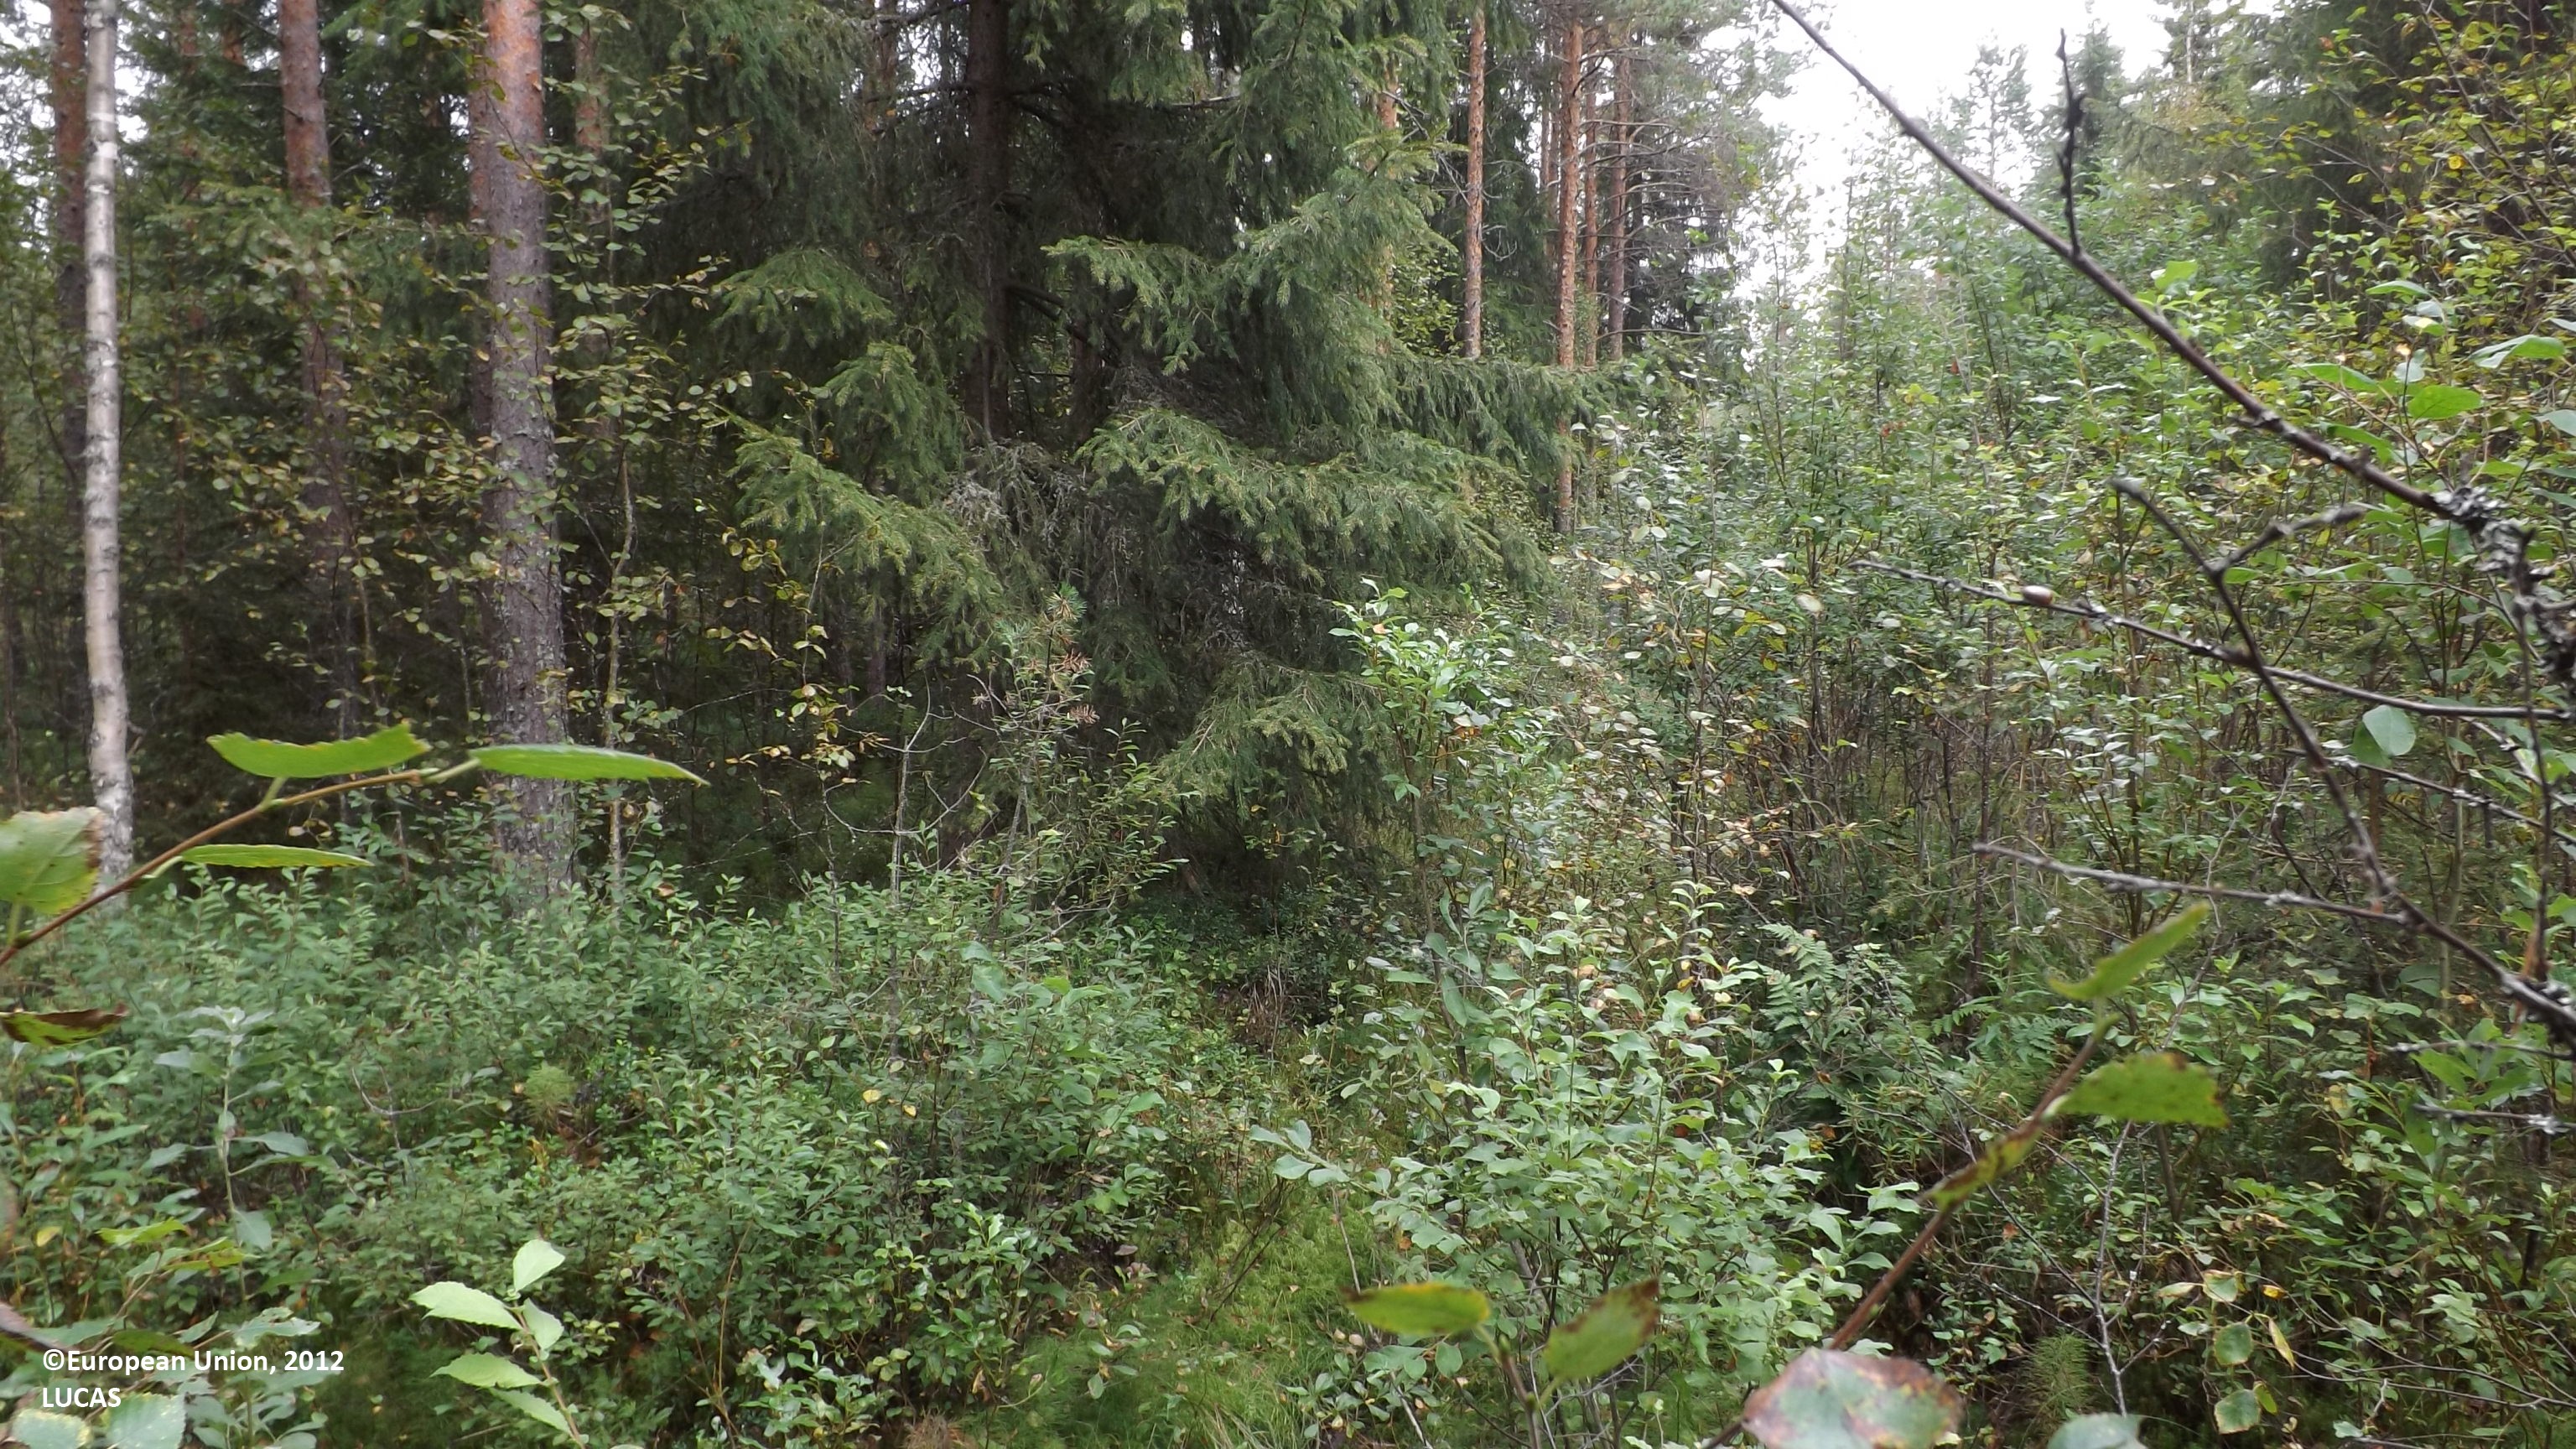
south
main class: Woodland
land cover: Other mixed woodland
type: boreal forest
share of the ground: 50 - 75 %
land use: Forestry
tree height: < 5 m
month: August
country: FI
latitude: 63.8367
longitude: 24.1153
